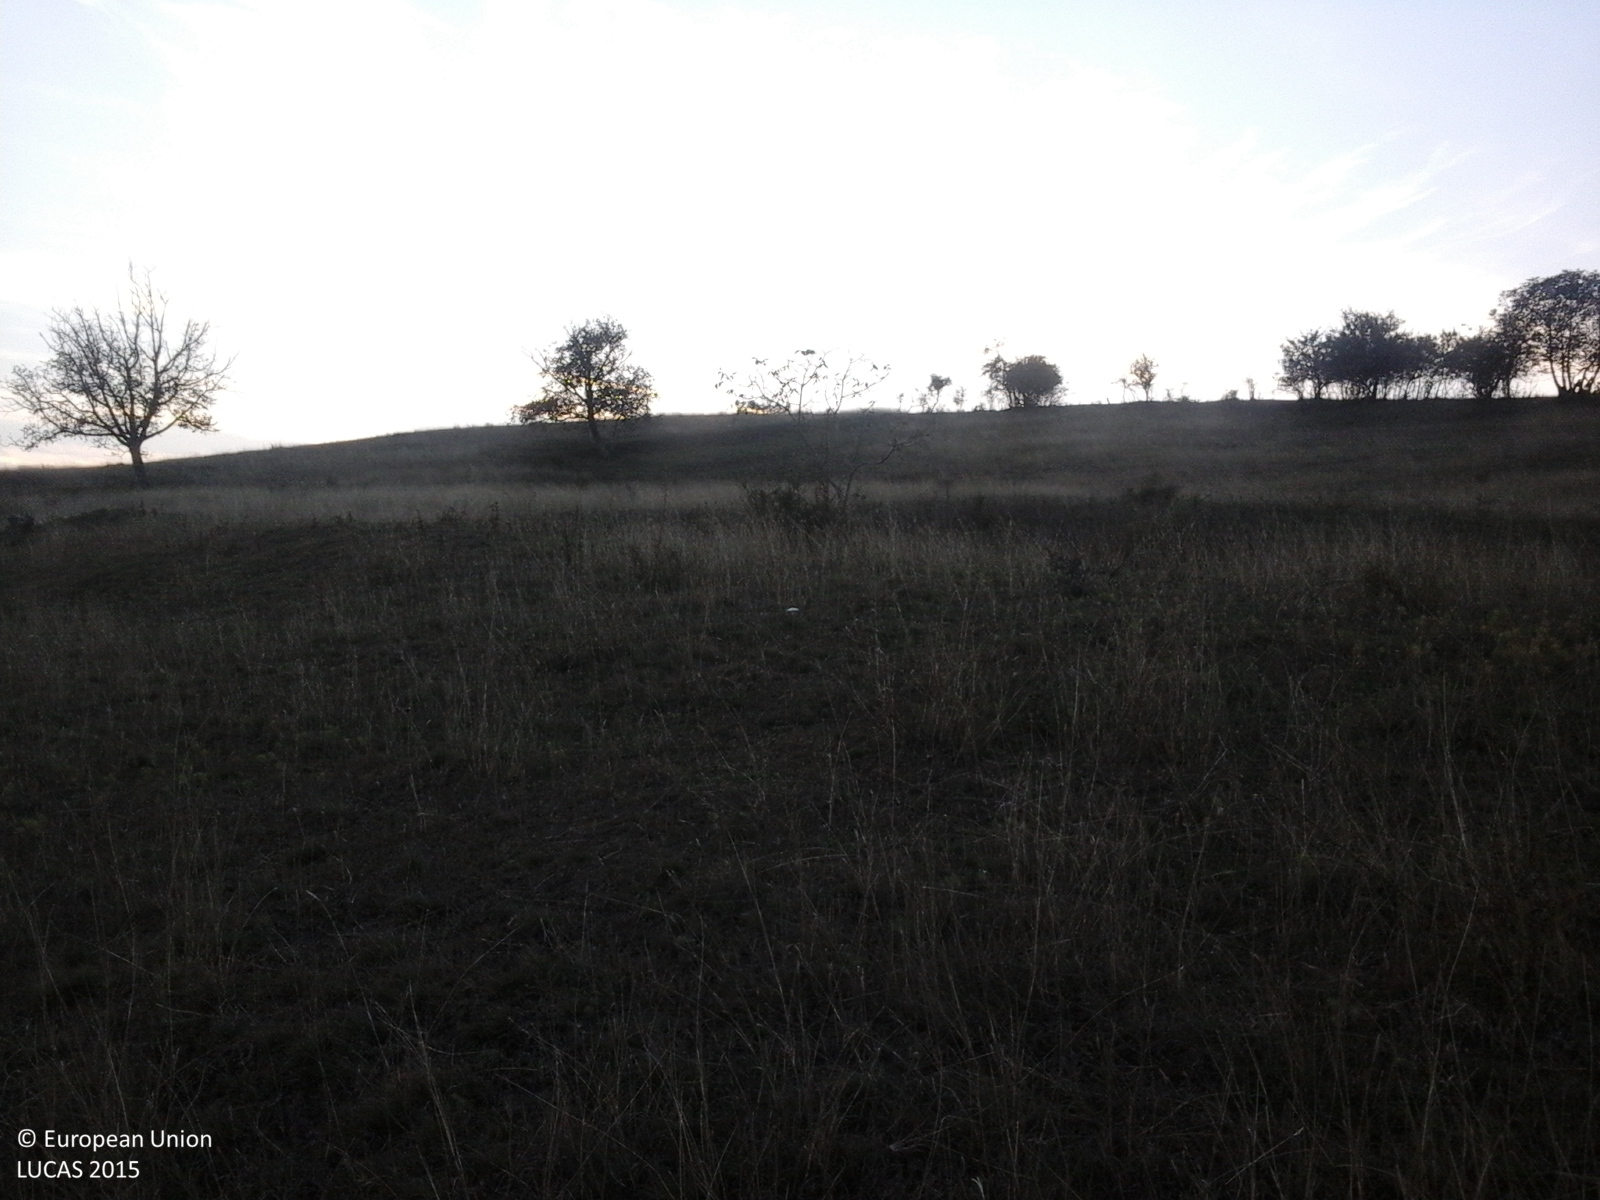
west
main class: Grassland
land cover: Grassland without tree/shrub cover
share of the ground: > 75 %
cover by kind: herbaceous plants 100 %
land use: Agriculture (excluding fallow land and kitchen gardens)
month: October
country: RO
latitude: 46.3153
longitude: 24.0367
